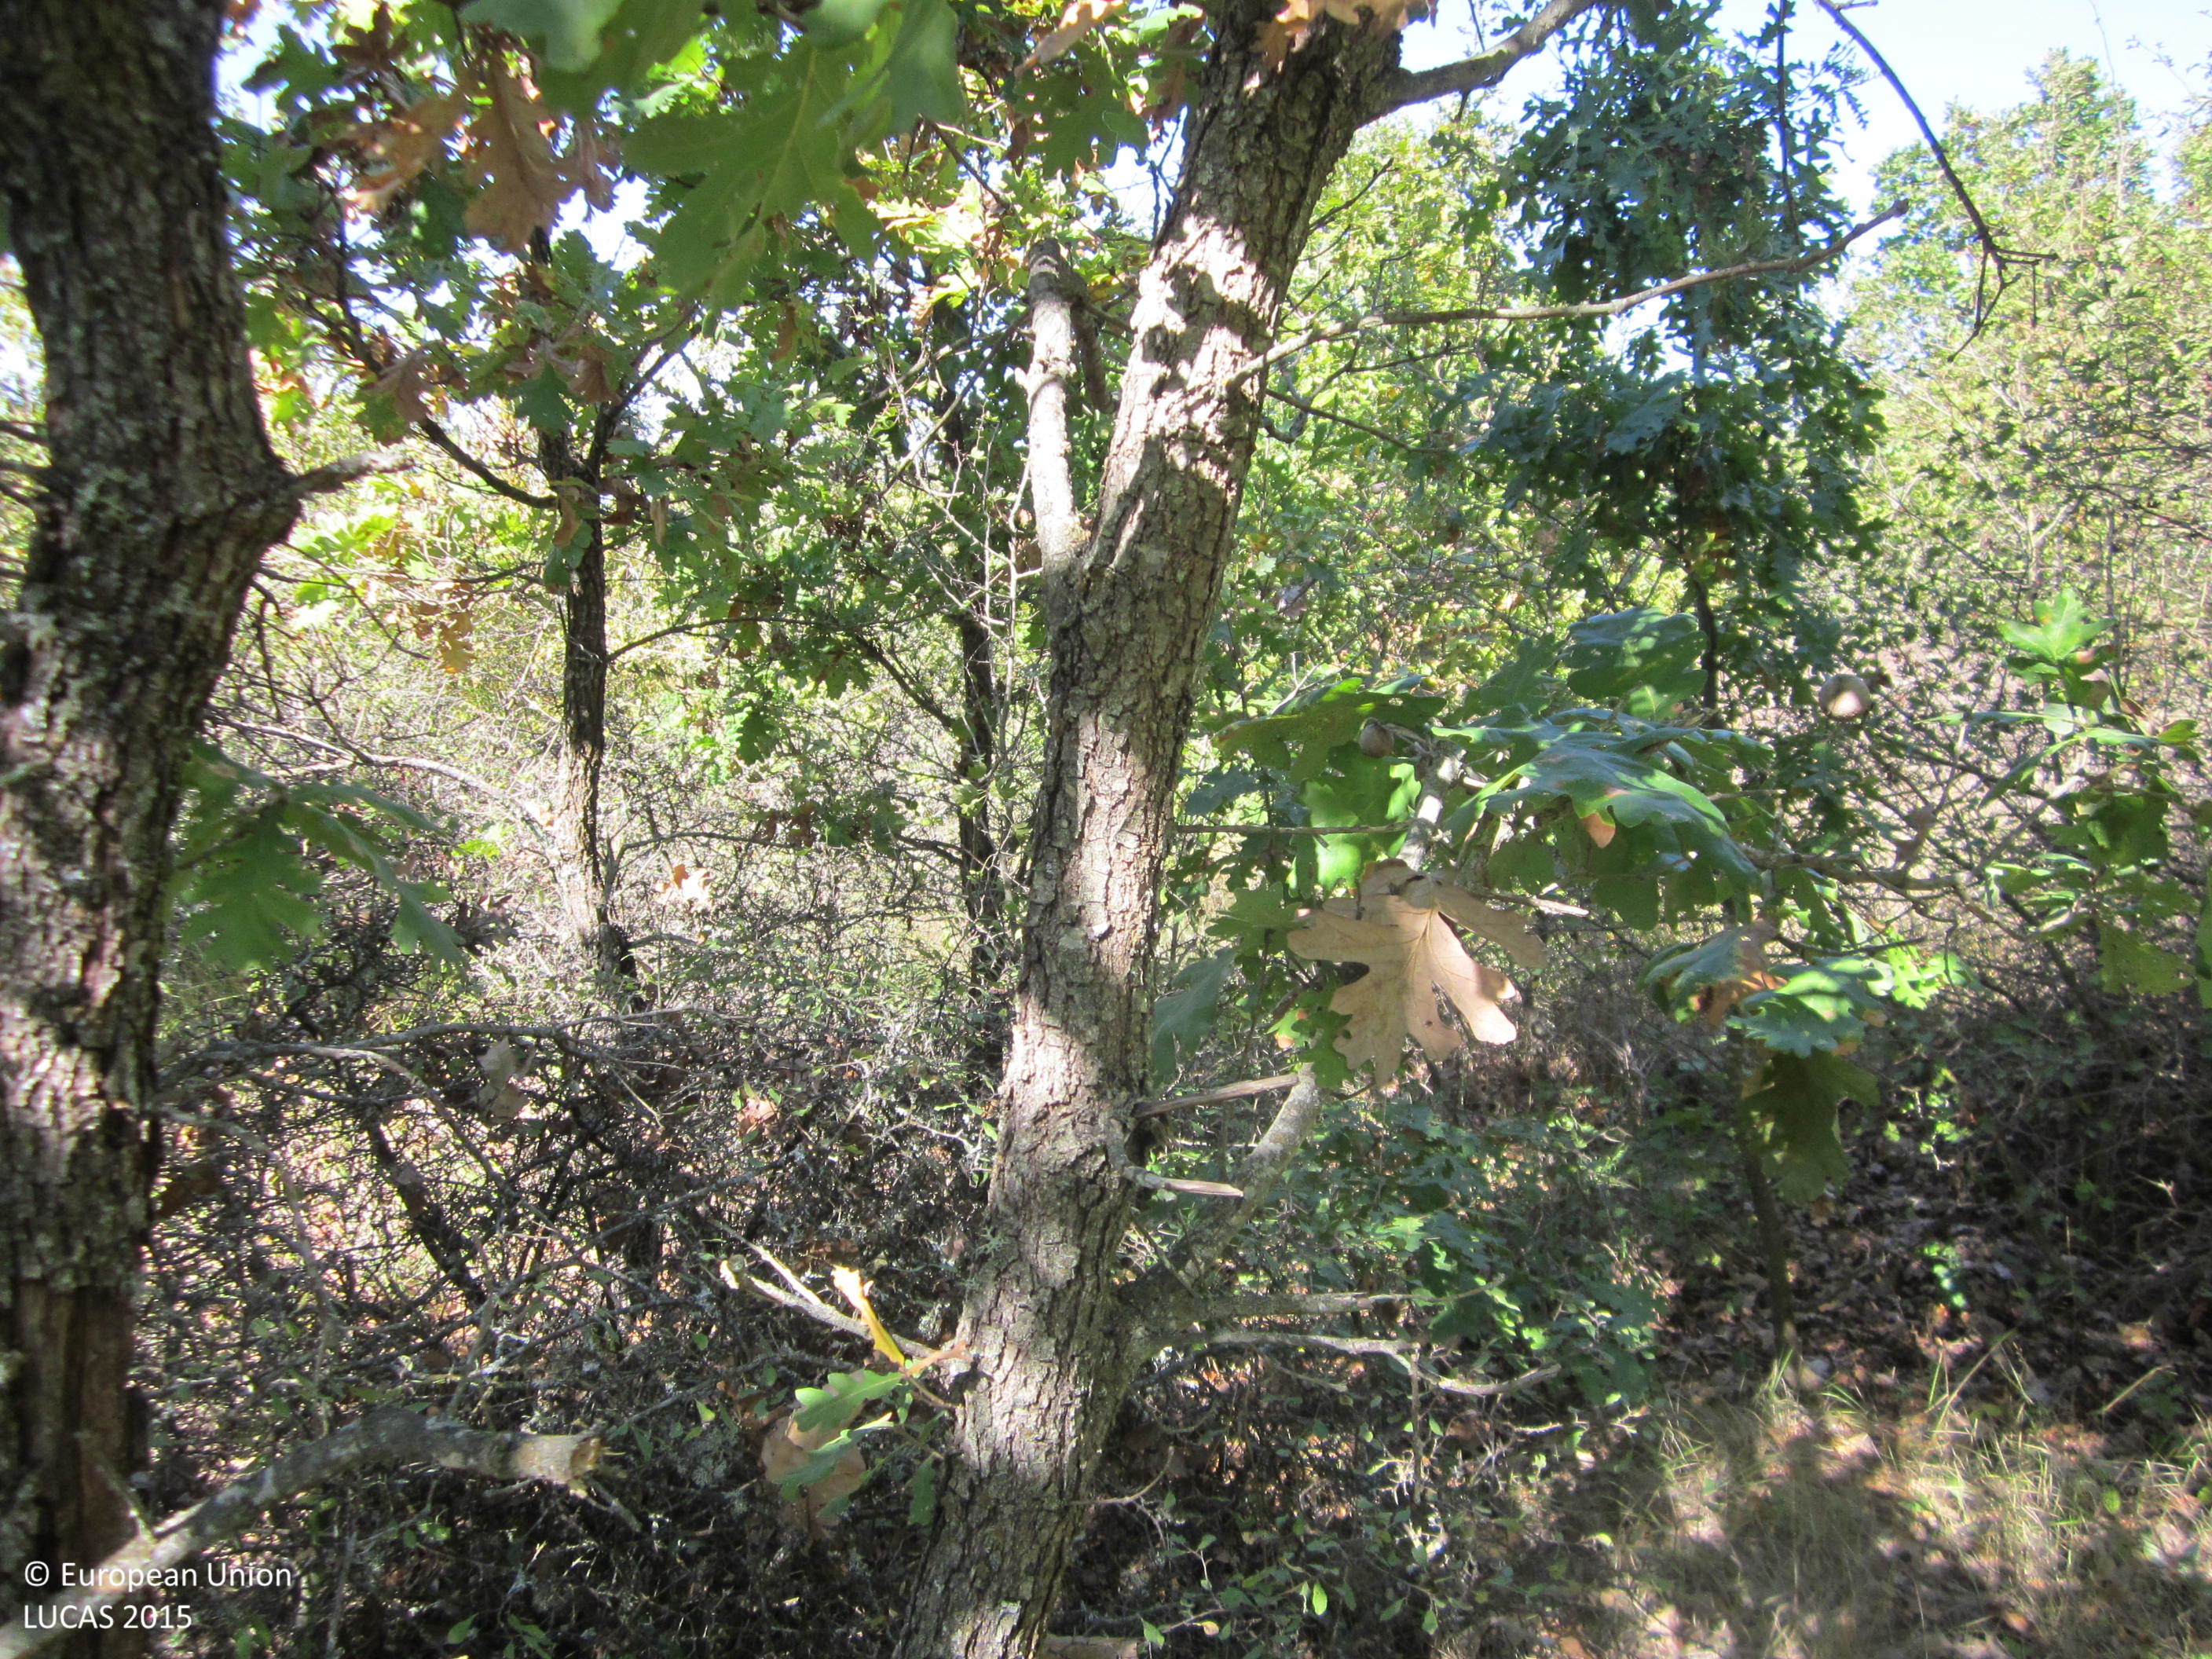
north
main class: Woodland
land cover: Broadleaved woodland
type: thermophilous deciduous forest
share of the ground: > 75 %
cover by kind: broadleaved forest trees 90 %, shrubs 5 %, herbaceous plants 5 %
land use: Forestry
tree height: > 5 m
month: September
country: BG
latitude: 42.2700
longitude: 27.0151
